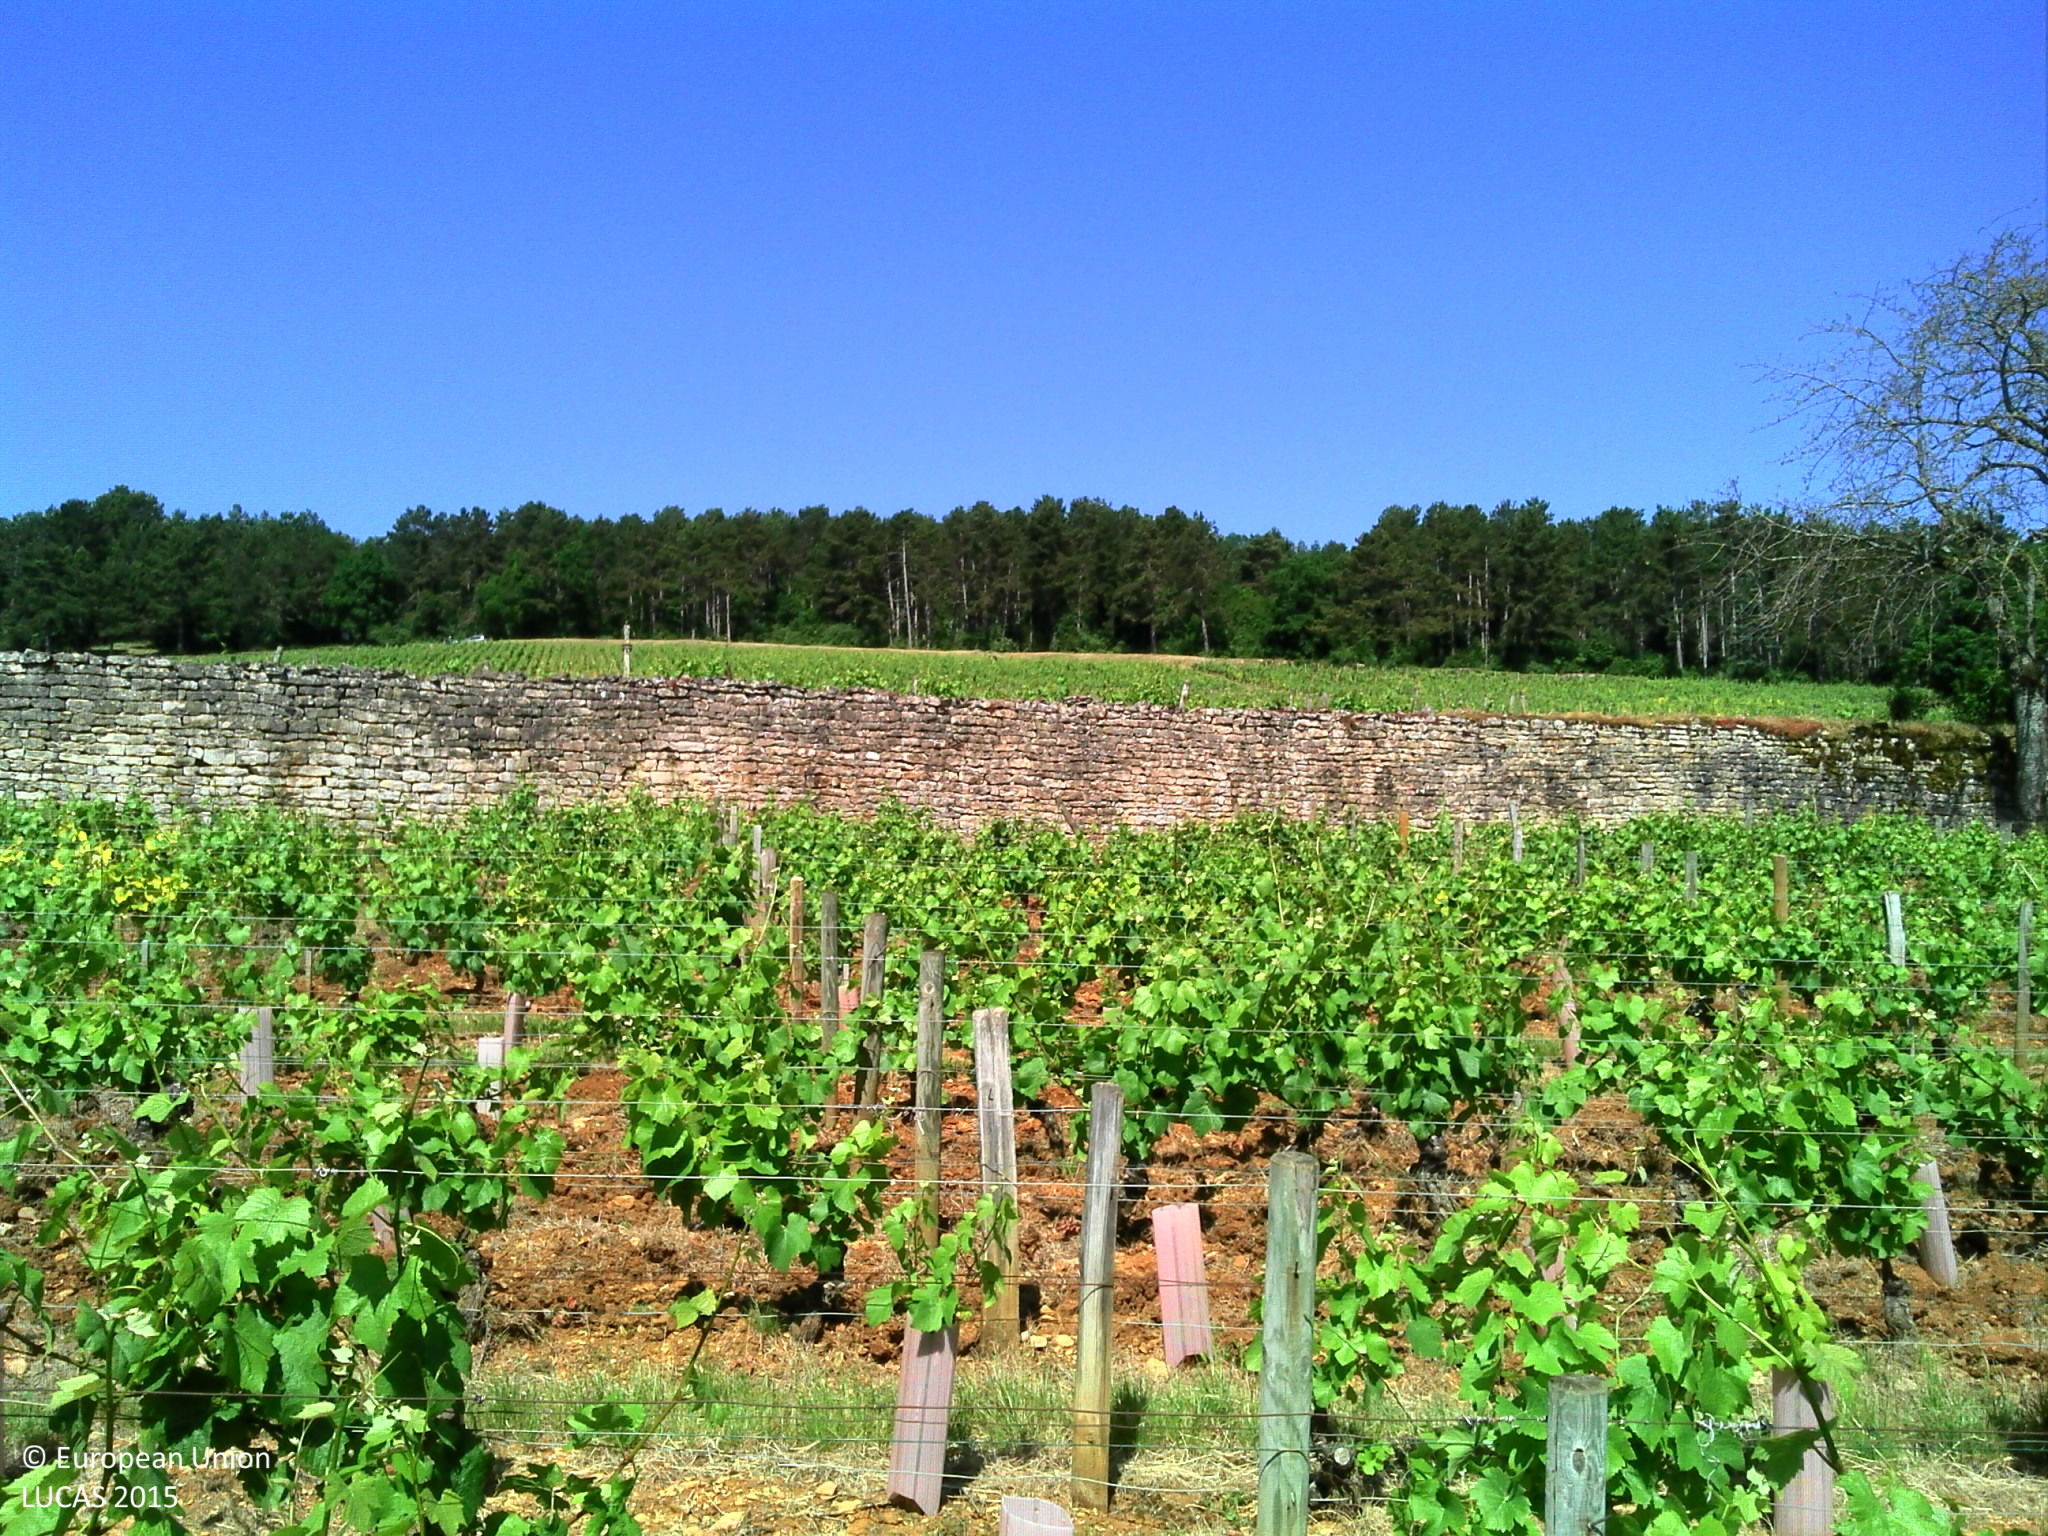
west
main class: Cropland
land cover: Vineyards
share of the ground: < 10 %
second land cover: Other bare soil
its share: > 75 %
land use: Agriculture (excluding fallow land and kitchen gardens)
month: June
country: FR
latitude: 47.2431
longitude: 4.9671
